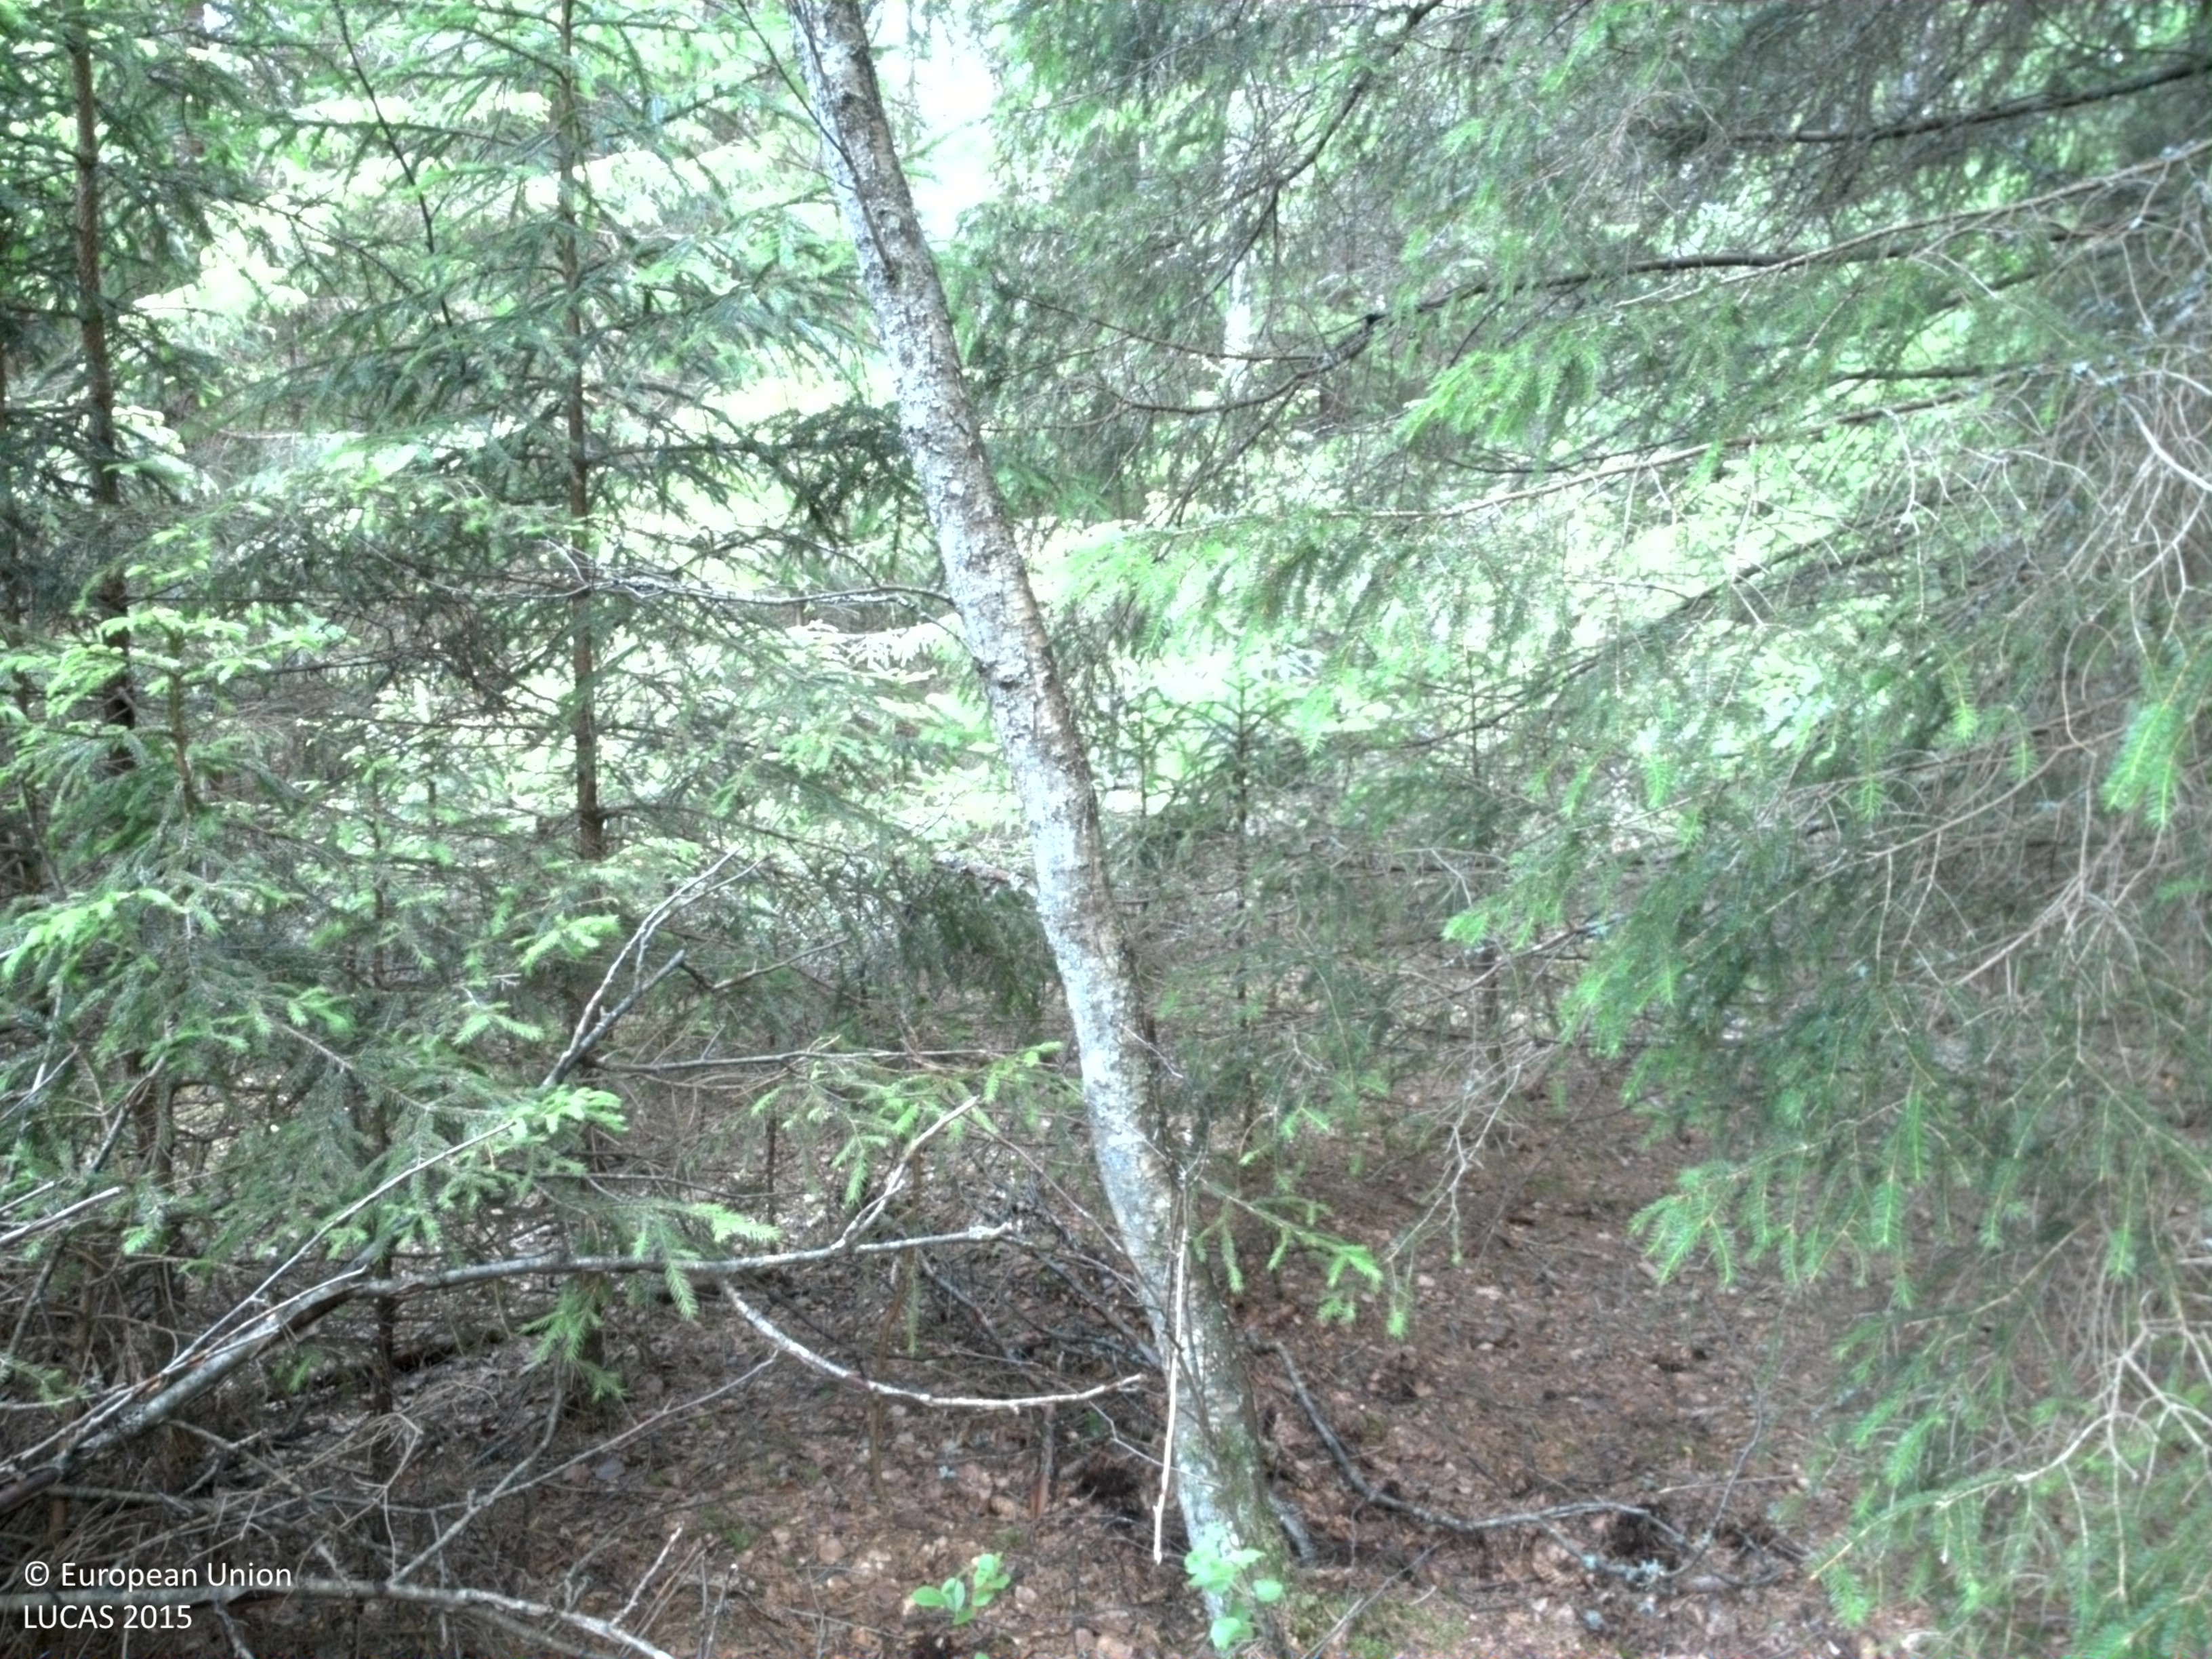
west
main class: Woodland
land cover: Spruce dominated coniferous woodland
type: boreal forest
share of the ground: 25 - 50 %
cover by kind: coniferous forest trees 50 %, lichens and mosses 20 %, consolidated bare surface 20 %, herbaceous plants 10 %
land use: Forestry
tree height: > 5 m
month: June
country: SE
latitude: 58.5754
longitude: 15.5139
